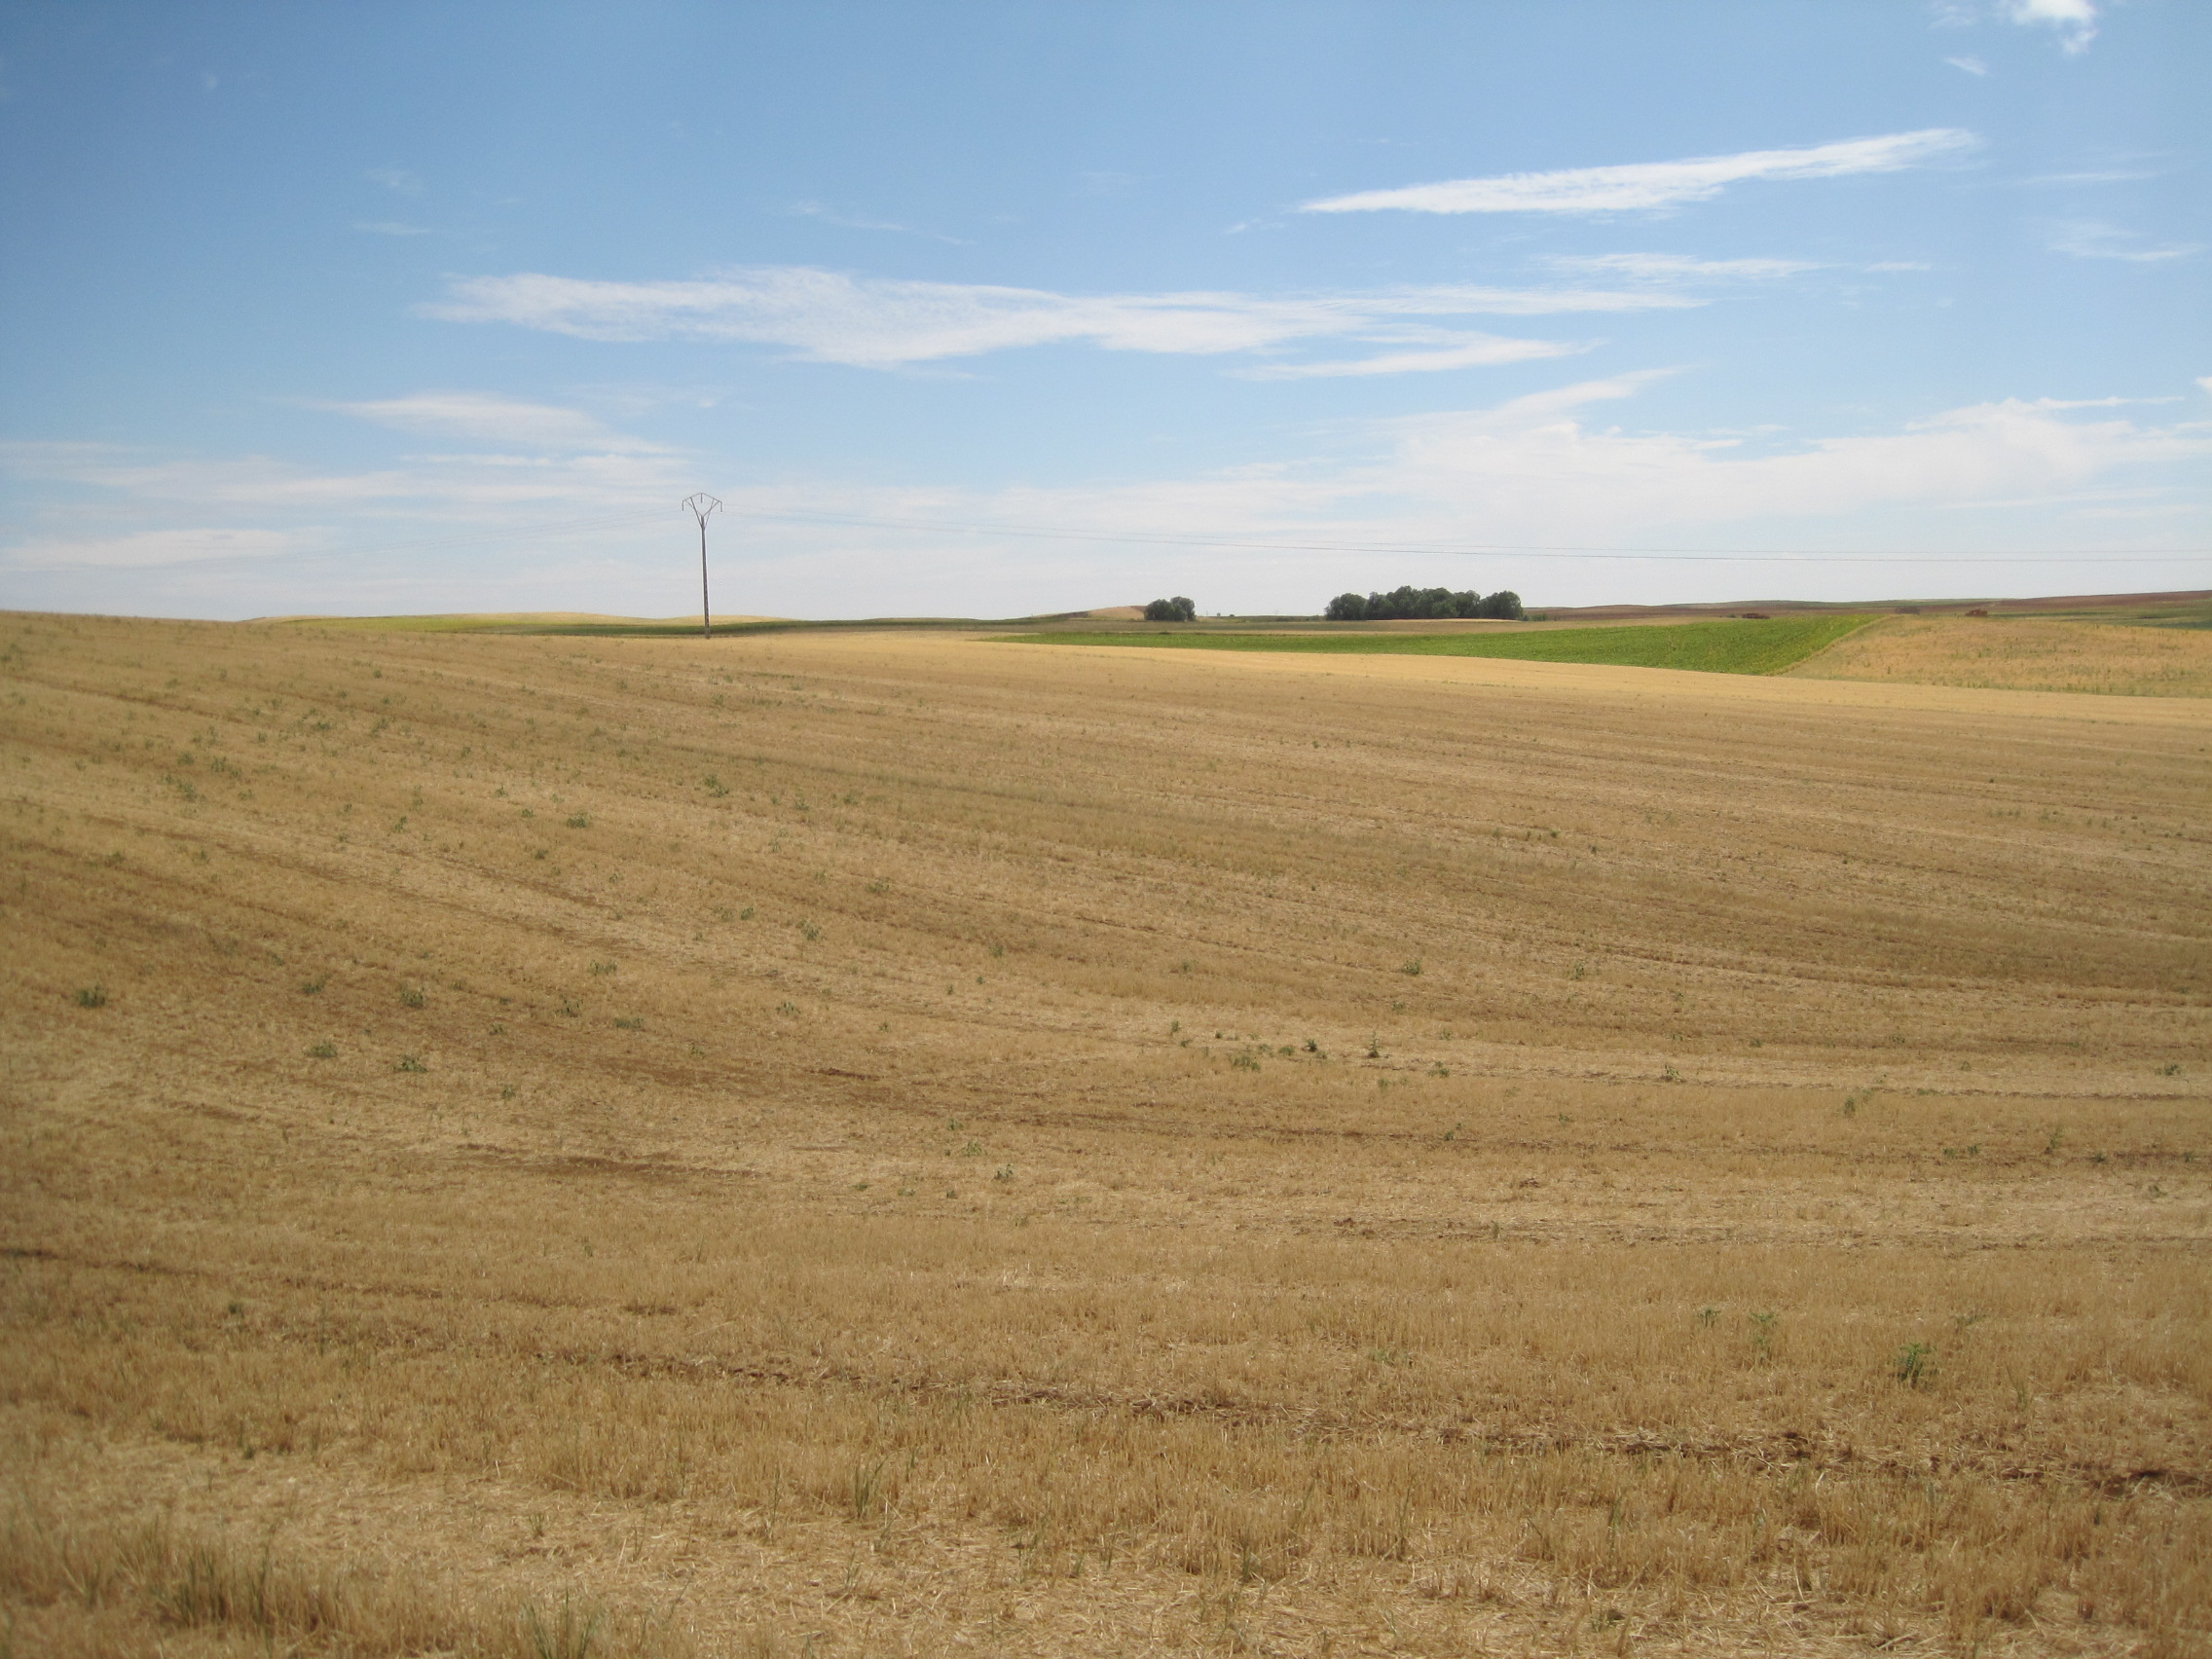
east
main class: Cropland
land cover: Barley
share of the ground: < 10 %
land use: Agriculture (excluding fallow land and kitchen gardens)
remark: Harvested field
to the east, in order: Barley; Electric lines; Barley
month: July
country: ES
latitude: 42.0638
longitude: -5.2259
